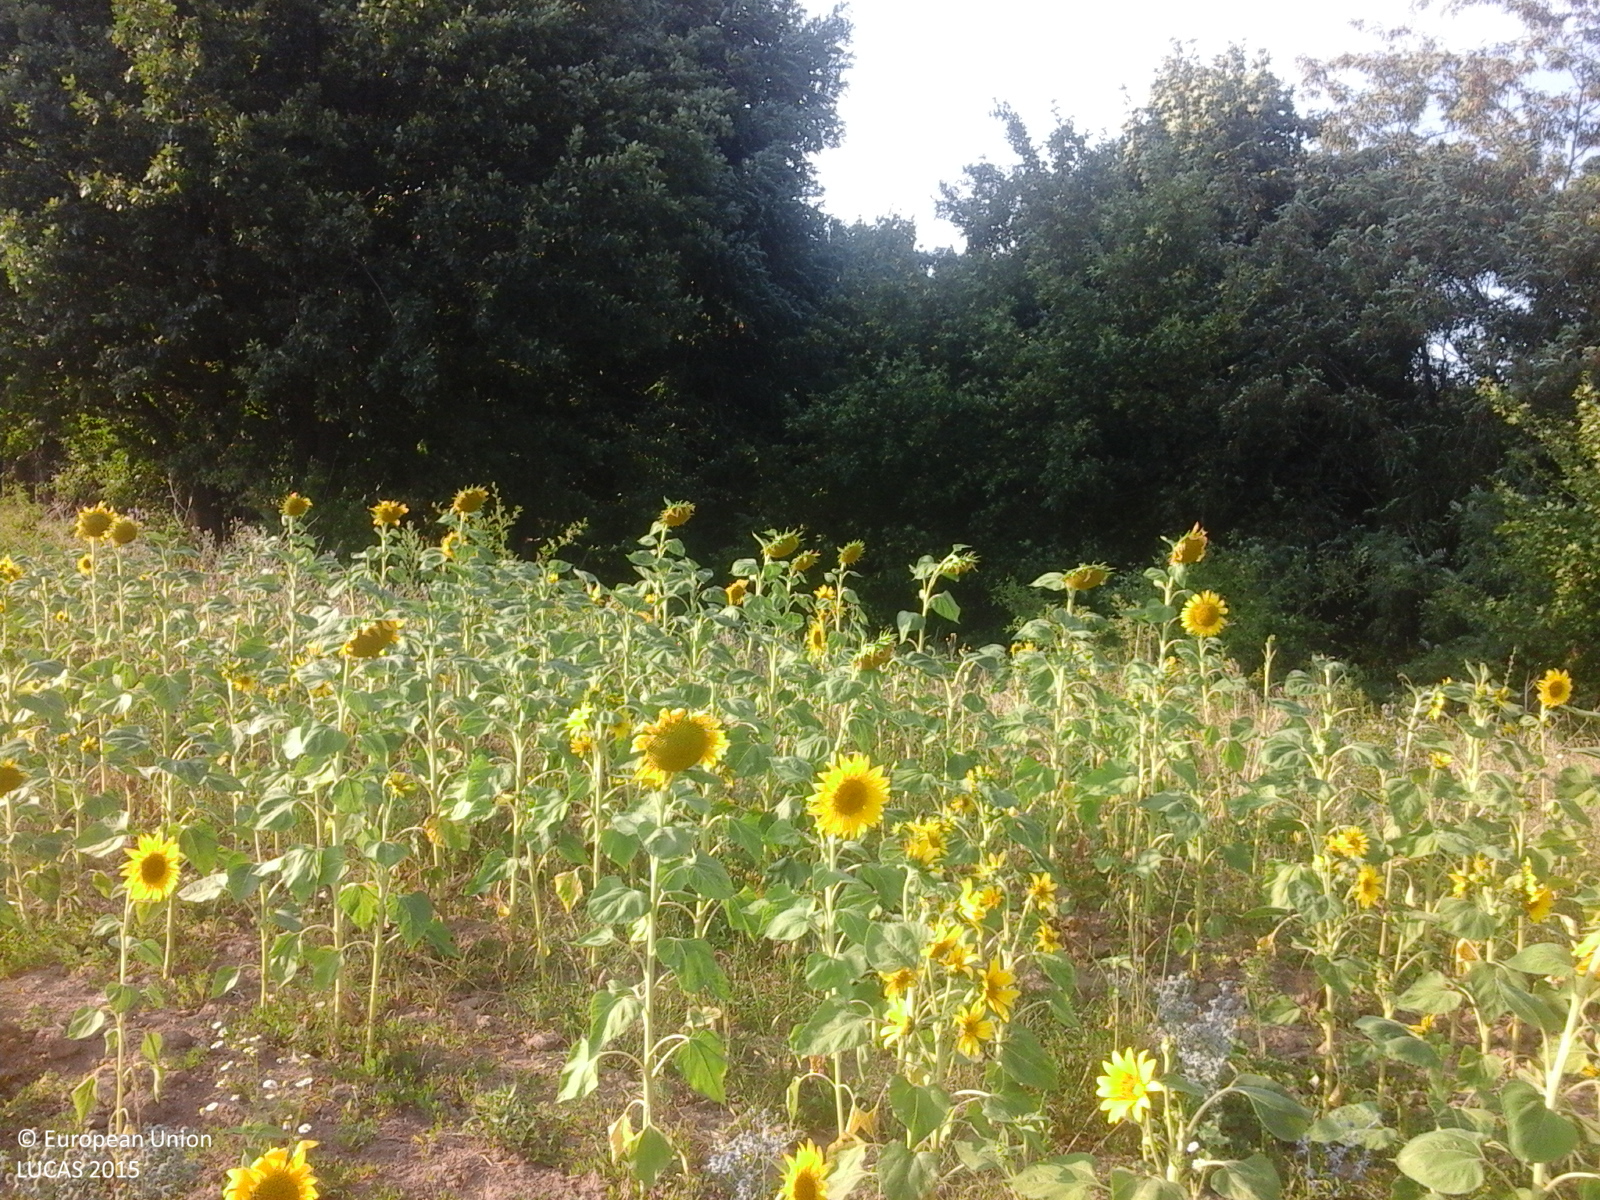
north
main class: Cropland
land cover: Sunflower
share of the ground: 50 - 75 %
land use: Agriculture (excluding fallow land and kitchen gardens)
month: July
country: RO
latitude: 46.4580
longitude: 27.1701
